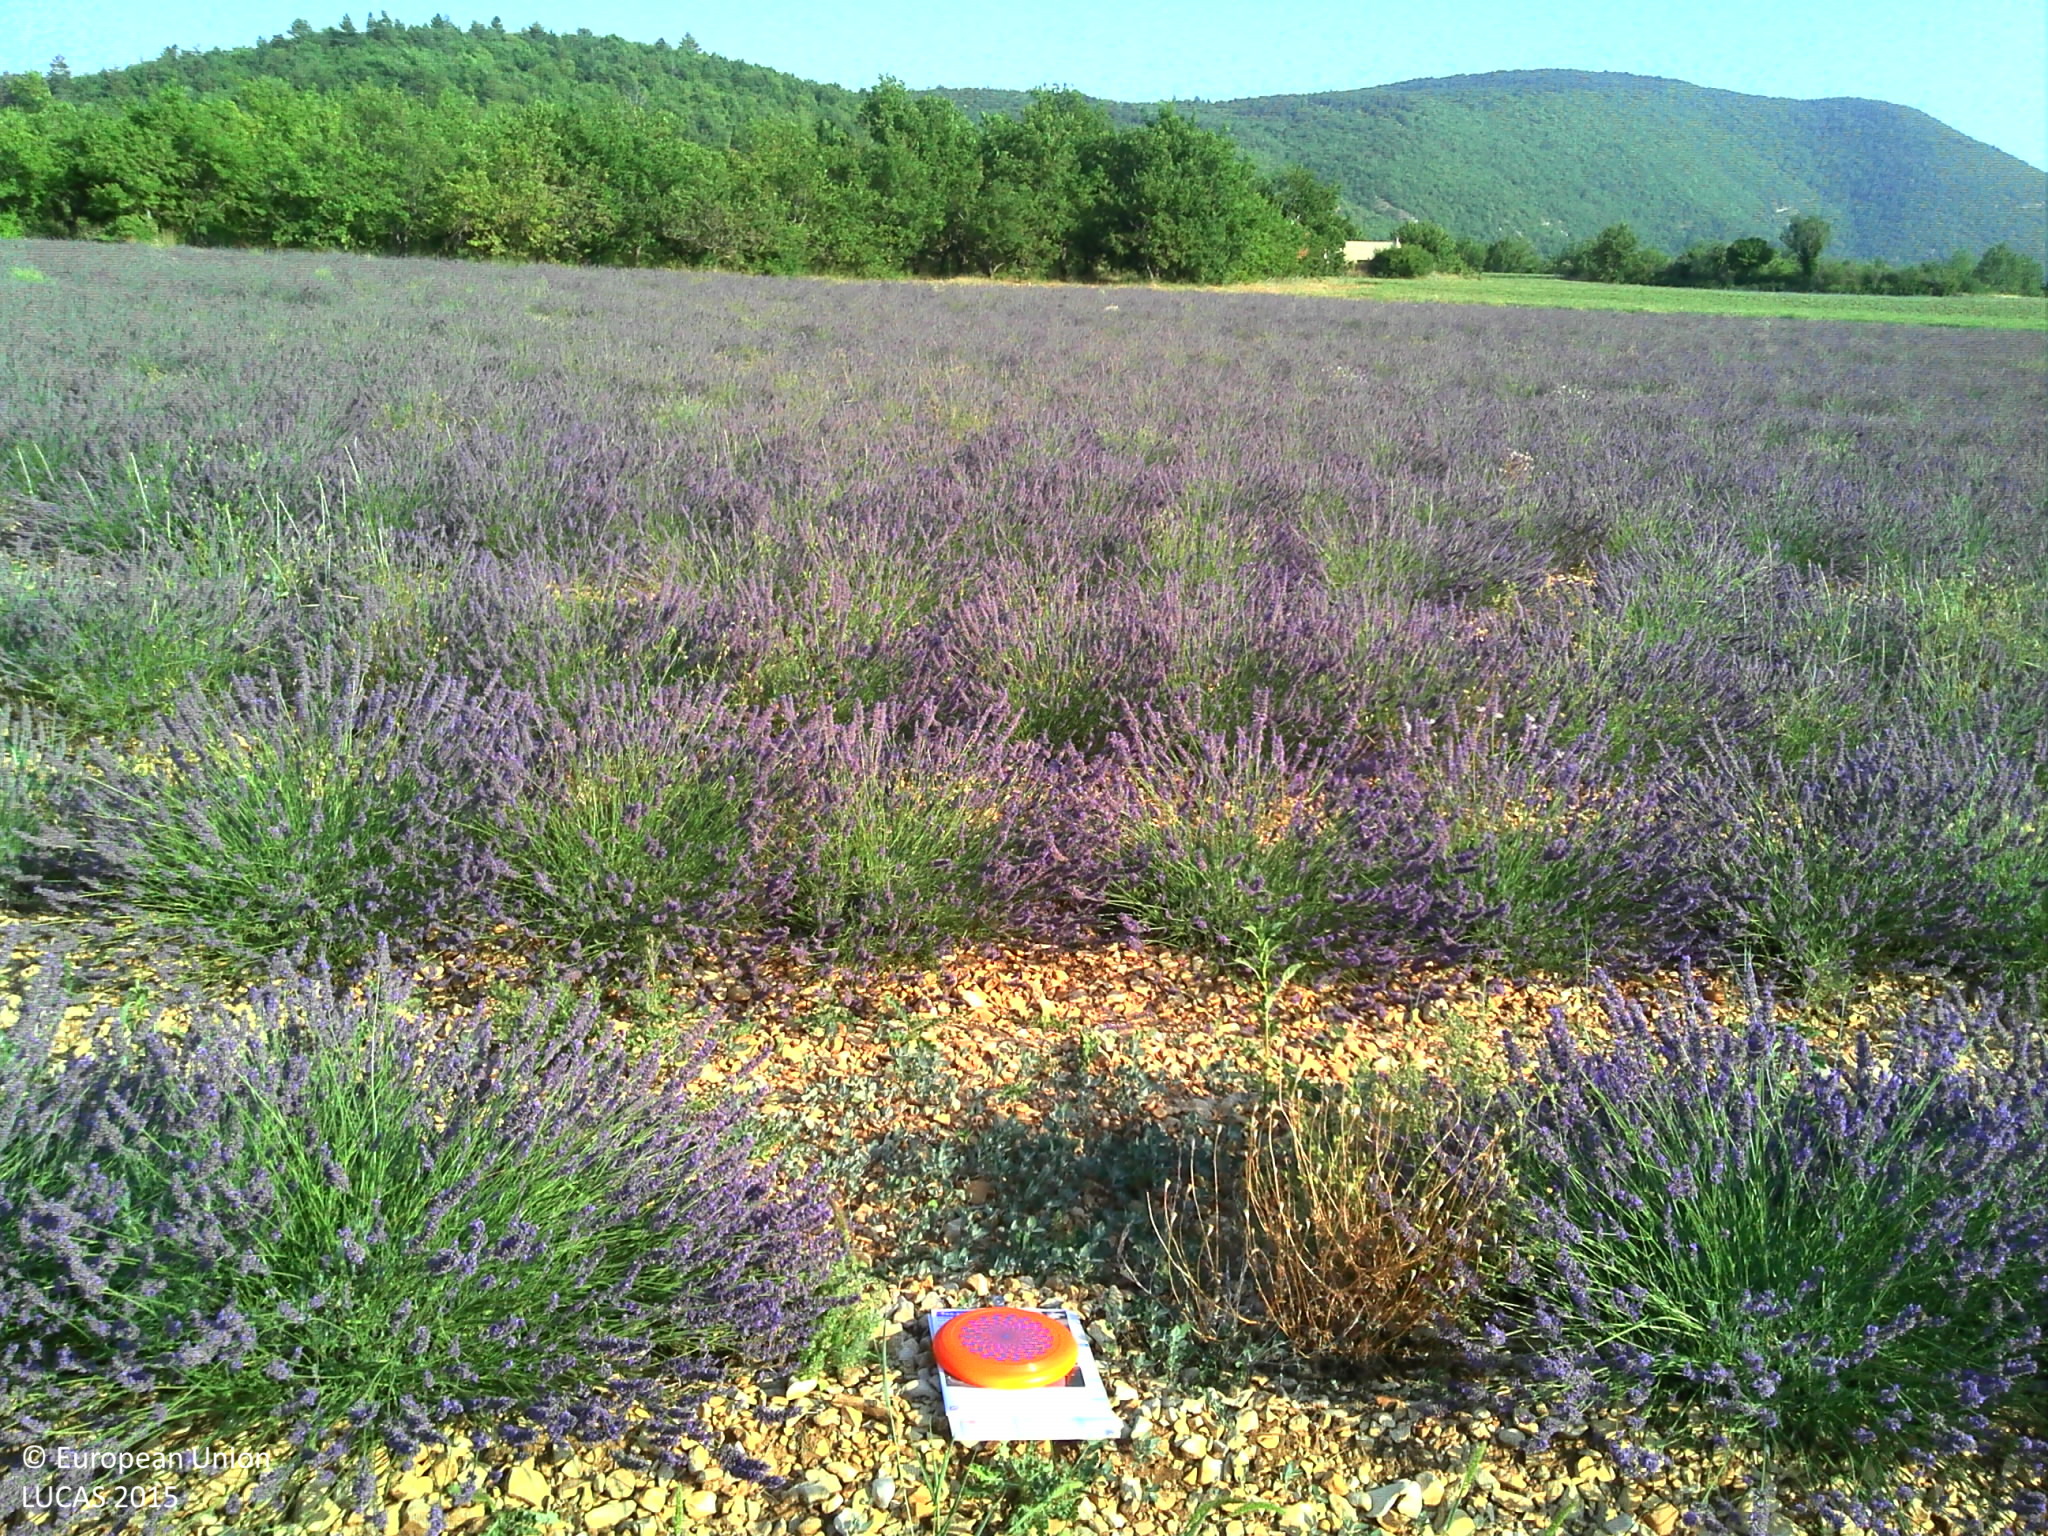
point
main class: Cropland
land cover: Permanent industrial crops
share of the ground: > 75 %
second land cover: Other bare soil
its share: > 75 %
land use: Agriculture (excluding fallow land and kitchen gardens)
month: July
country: FR
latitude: 44.0860
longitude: 5.3997
